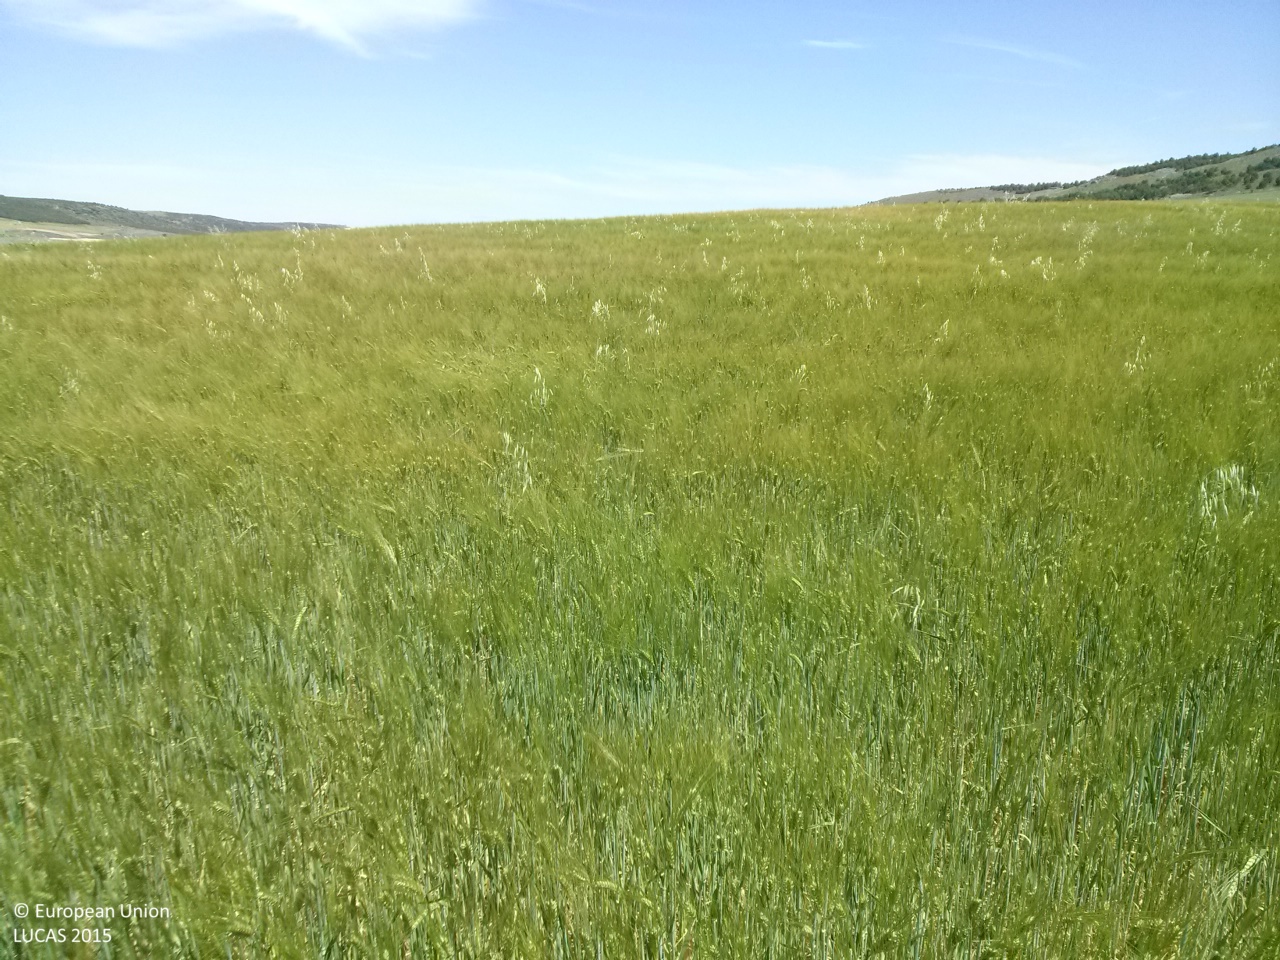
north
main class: Cropland
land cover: Barley
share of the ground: > 75 %
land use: Agriculture (excluding fallow land and kitchen gardens)
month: May
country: ES
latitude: 40.0219
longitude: -2.8524
